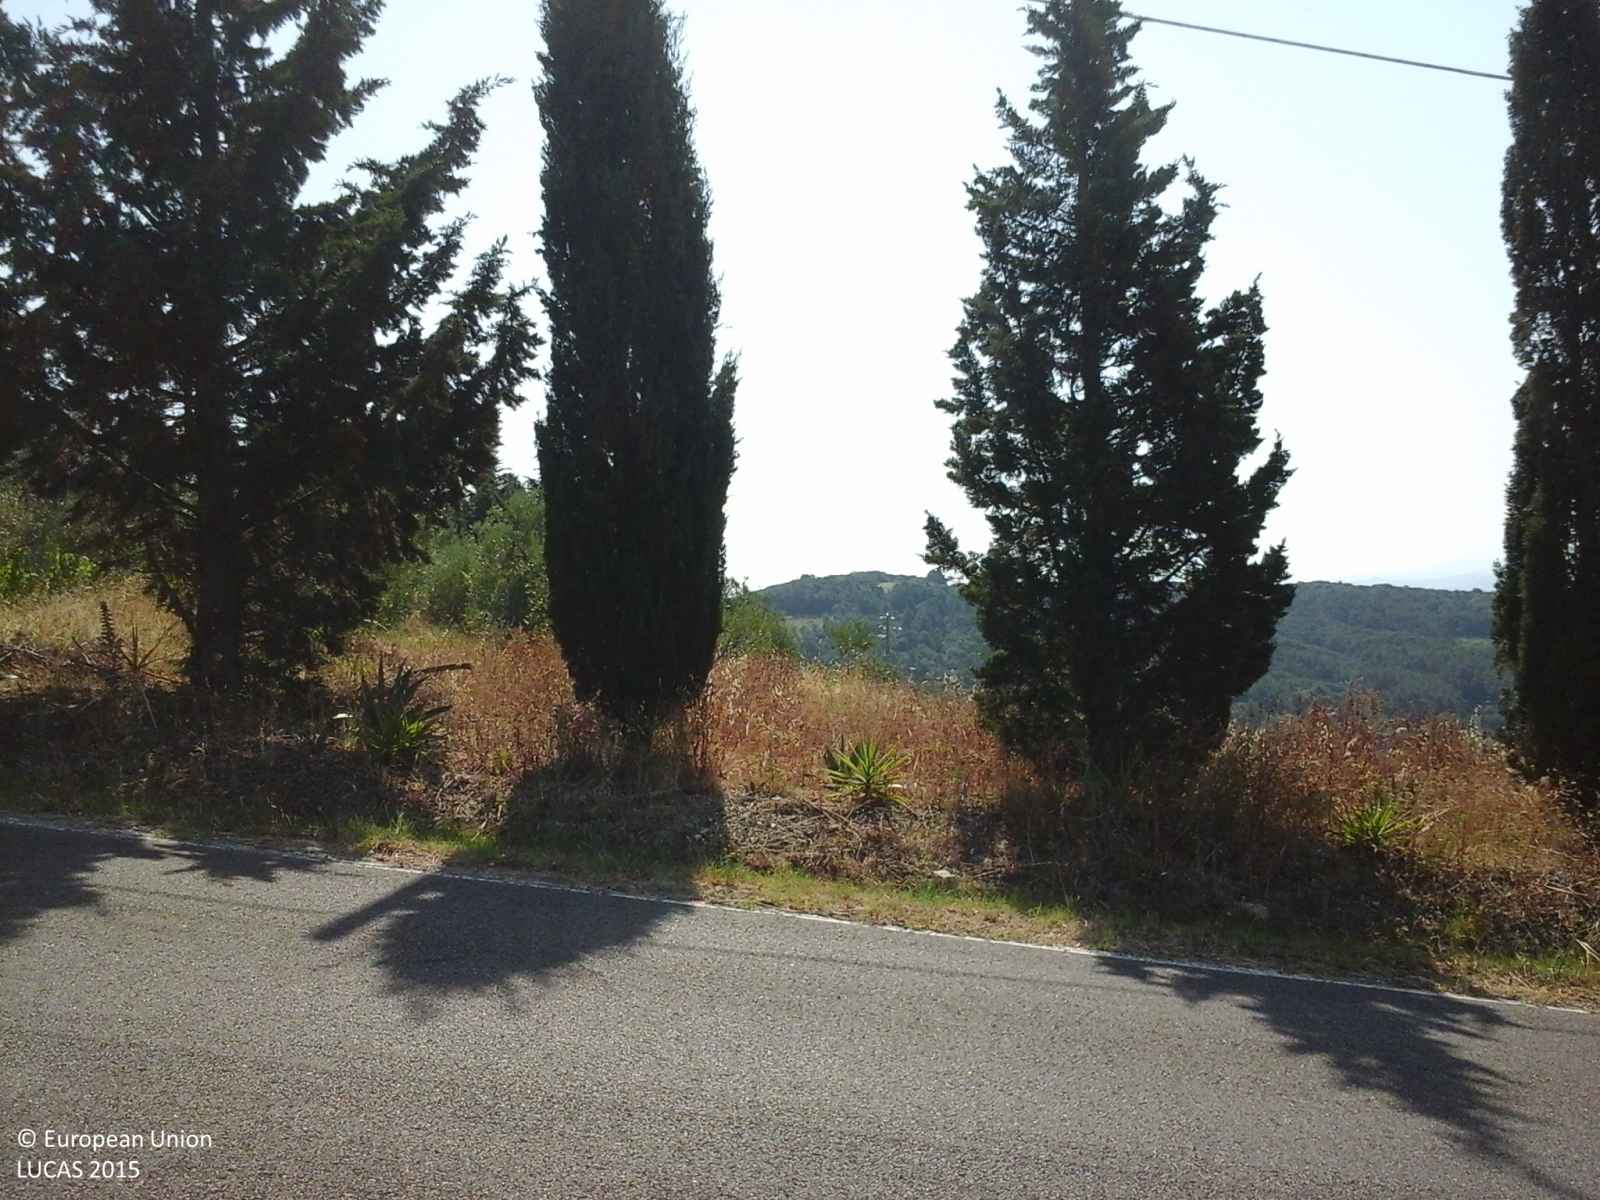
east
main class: Cropland
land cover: Temporary grasslands
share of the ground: > 75 %
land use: Agriculture (excluding fallow land and kitchen gardens)
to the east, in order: Temporary grasslands; Electric lines; Temporary grasslands; Paved roads, cycling and walking lanes; Electric lines; Lines of trees; Olive groves; Artificial constructions in urban areas; Shrubland without tree cover; Lucerne
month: August
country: IT
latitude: 43.3745
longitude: 10.6030
